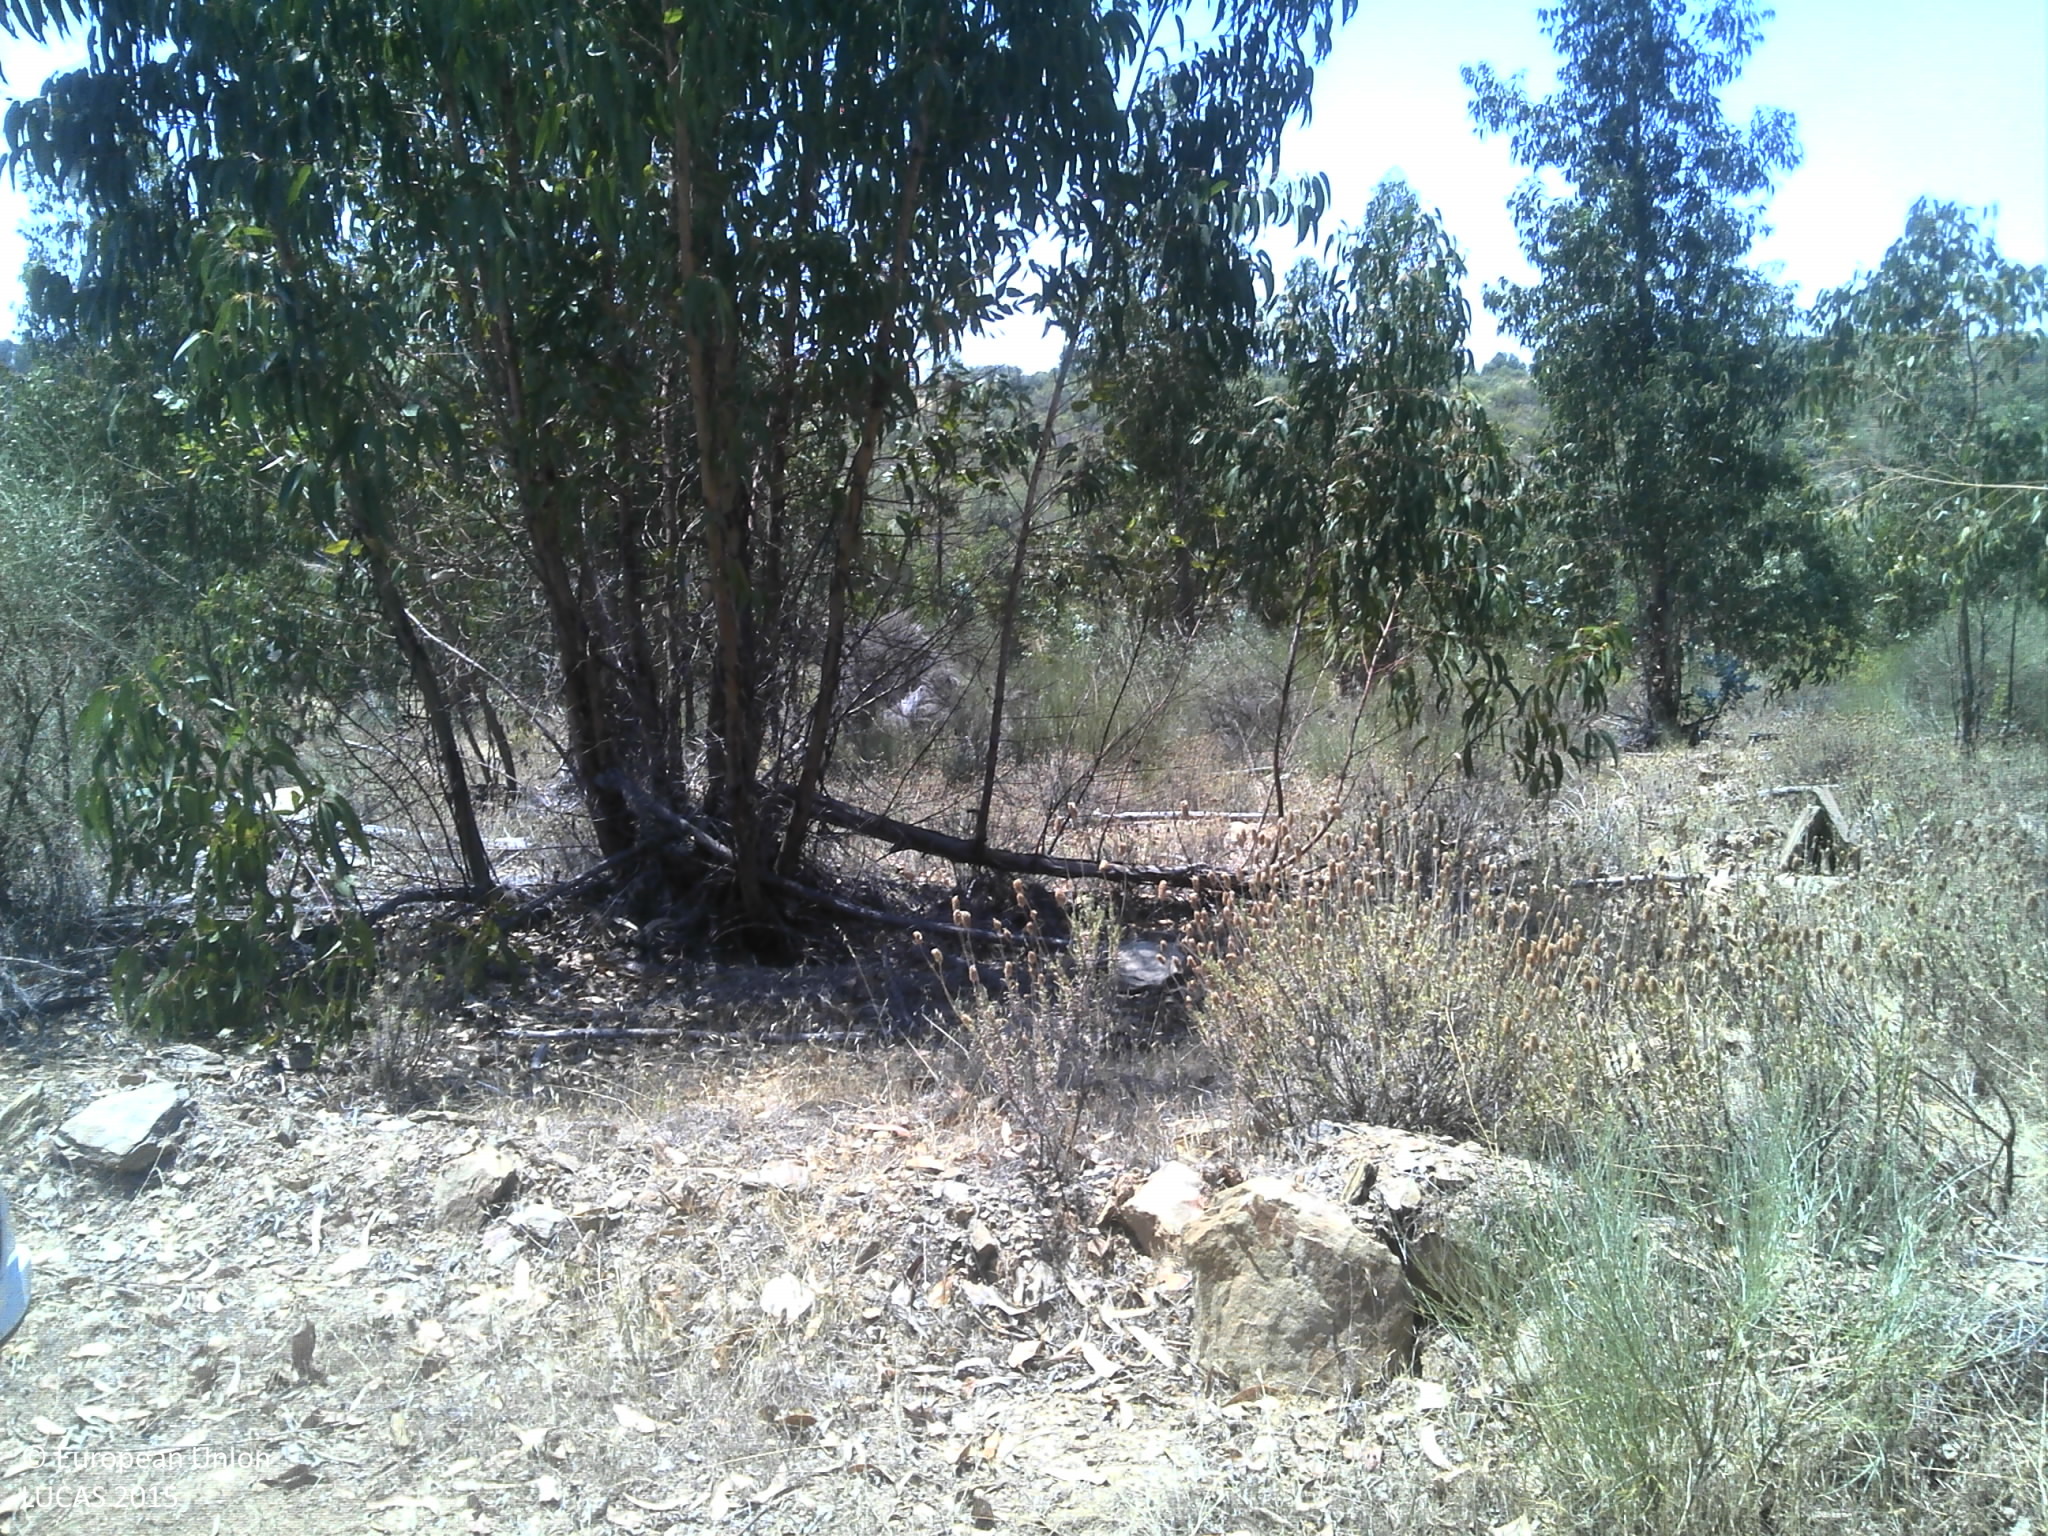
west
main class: Woodland
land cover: Broadleaved woodland
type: exotic forest
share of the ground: 25 - 50 %
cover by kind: broadleaved forest trees 50 %, unconsolidated bare surface 35 %, shrubs 15 %
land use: Forestry
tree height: > 5 m
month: June
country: PT
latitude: 39.7669
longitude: -7.0017
